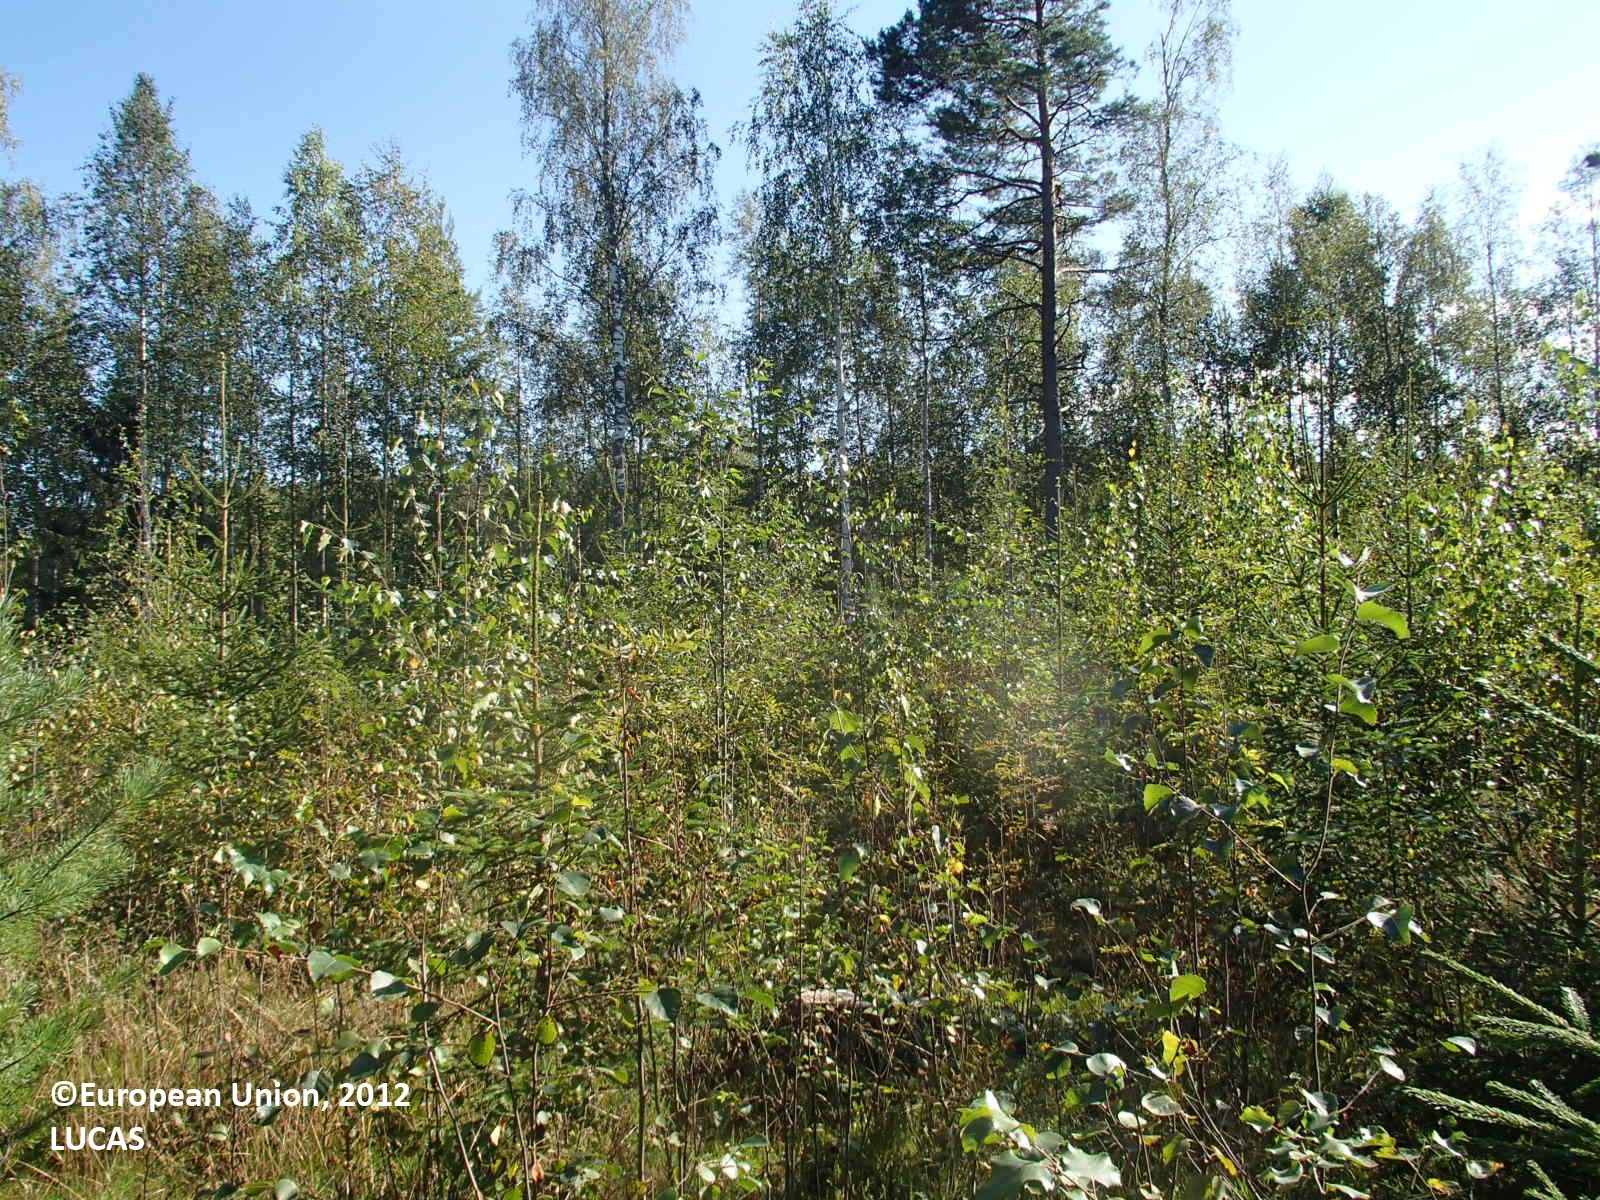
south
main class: Woodland
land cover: Spruce dominated mixed woodland
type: boreal forest
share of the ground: > 75 %
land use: Forestry
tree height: < 5 m
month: August
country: FI
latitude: 63.5529
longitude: 27.8982
